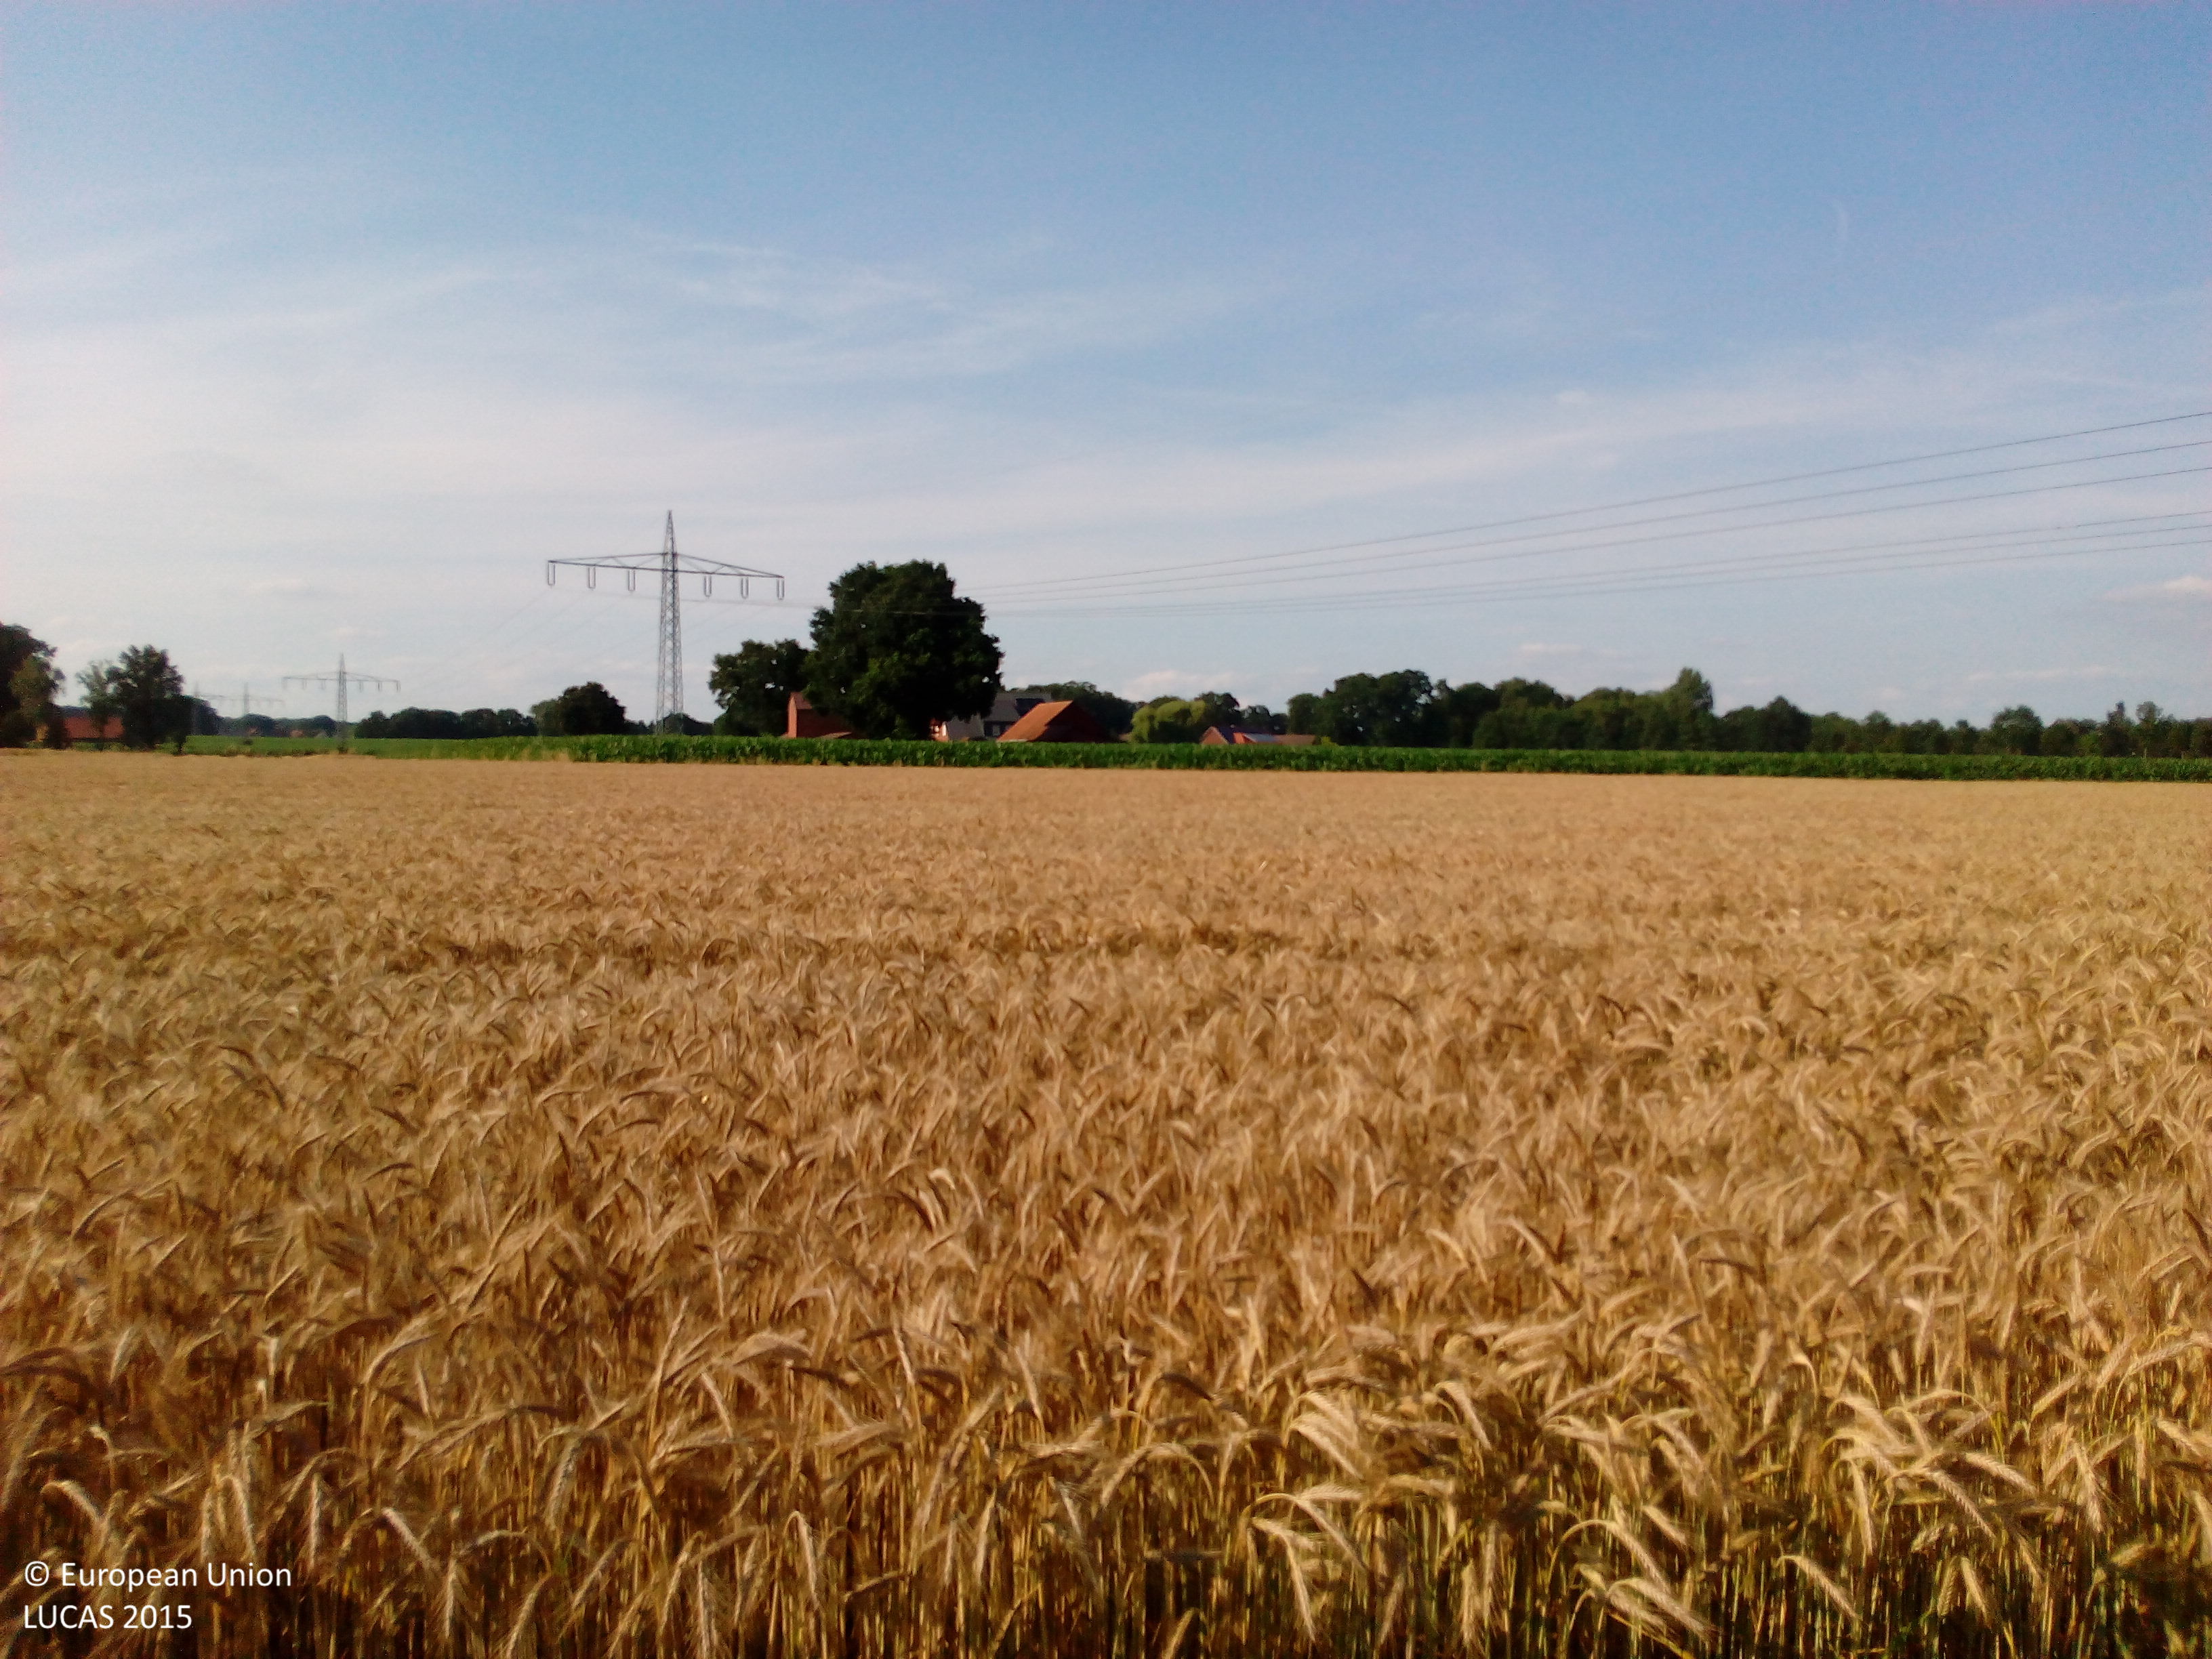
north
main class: Cropland
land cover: Barley
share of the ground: > 75 %
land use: Agriculture (excluding fallow land and kitchen gardens)
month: July
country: DE
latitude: 52.4857
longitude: 7.9536
